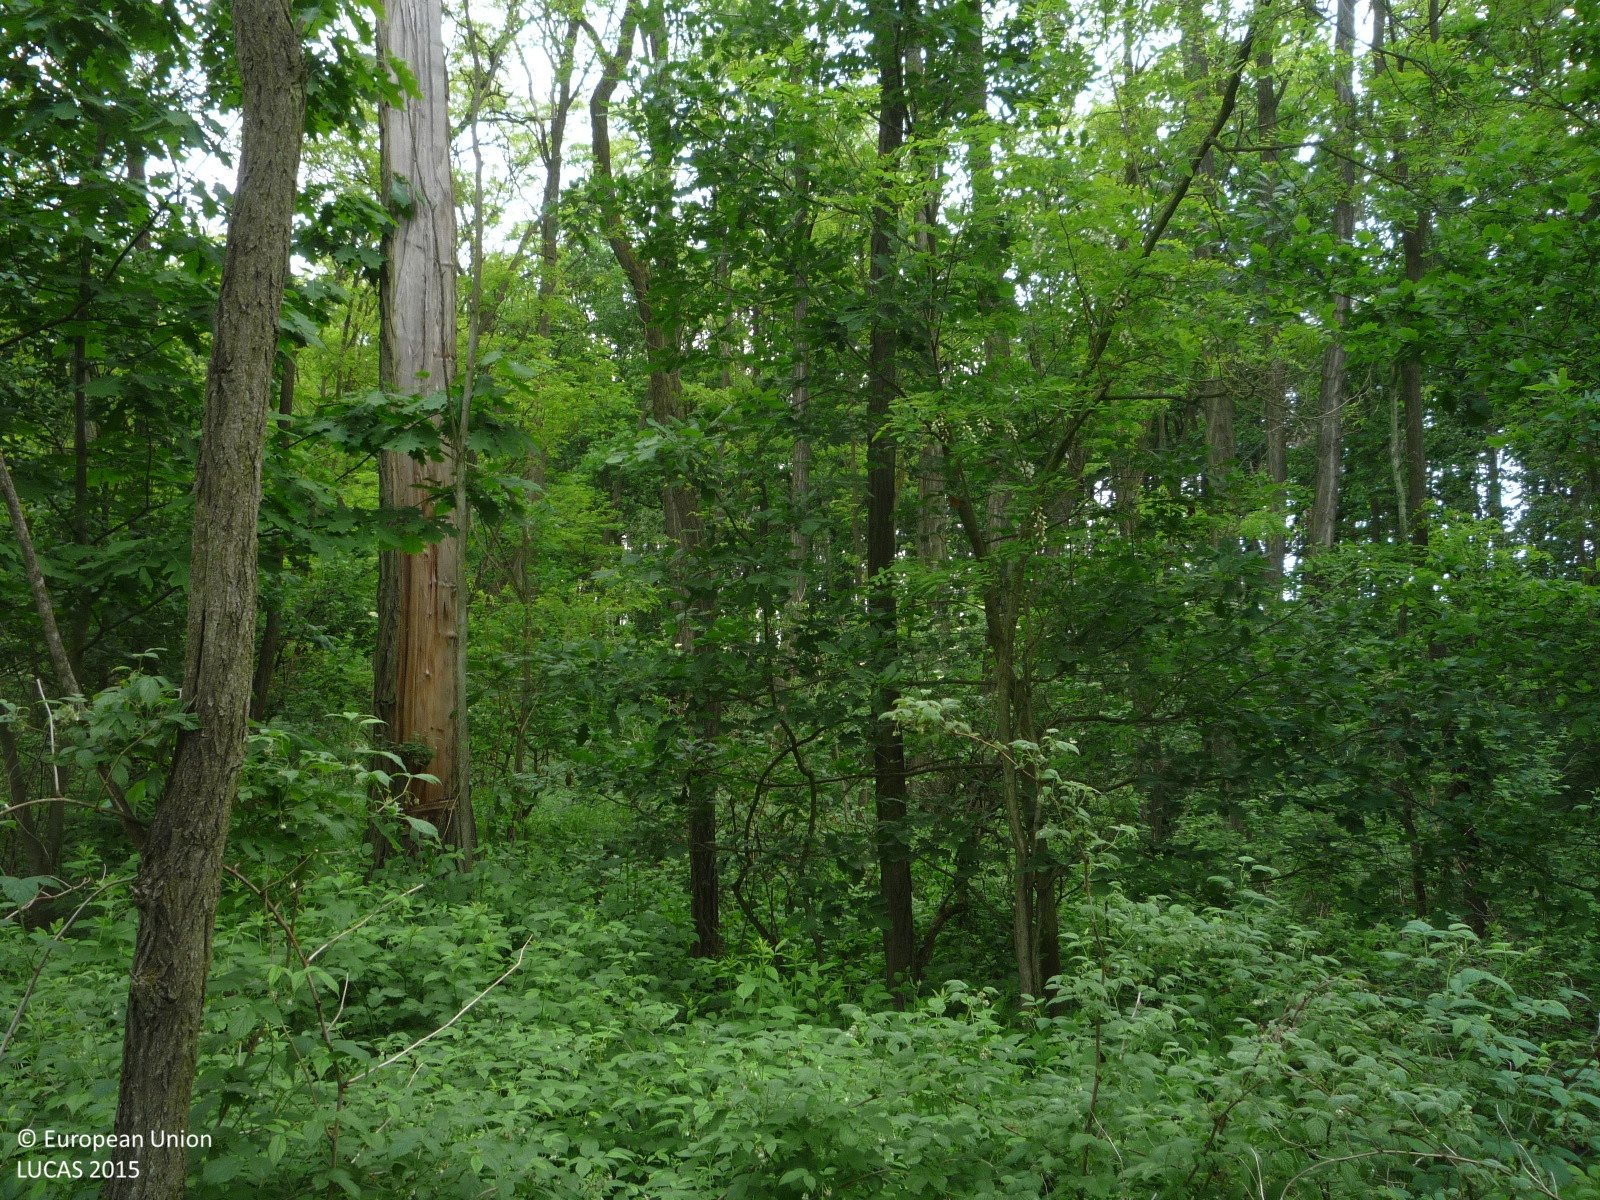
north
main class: Woodland
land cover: Broadleaved woodland
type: mesophytic deciduous forest
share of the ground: > 75 %
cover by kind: broadleaved forest trees 90 %, shrubs 10 %
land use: Forestry
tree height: > 5 m
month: May
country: CZ
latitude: 50.3841
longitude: 14.4881
